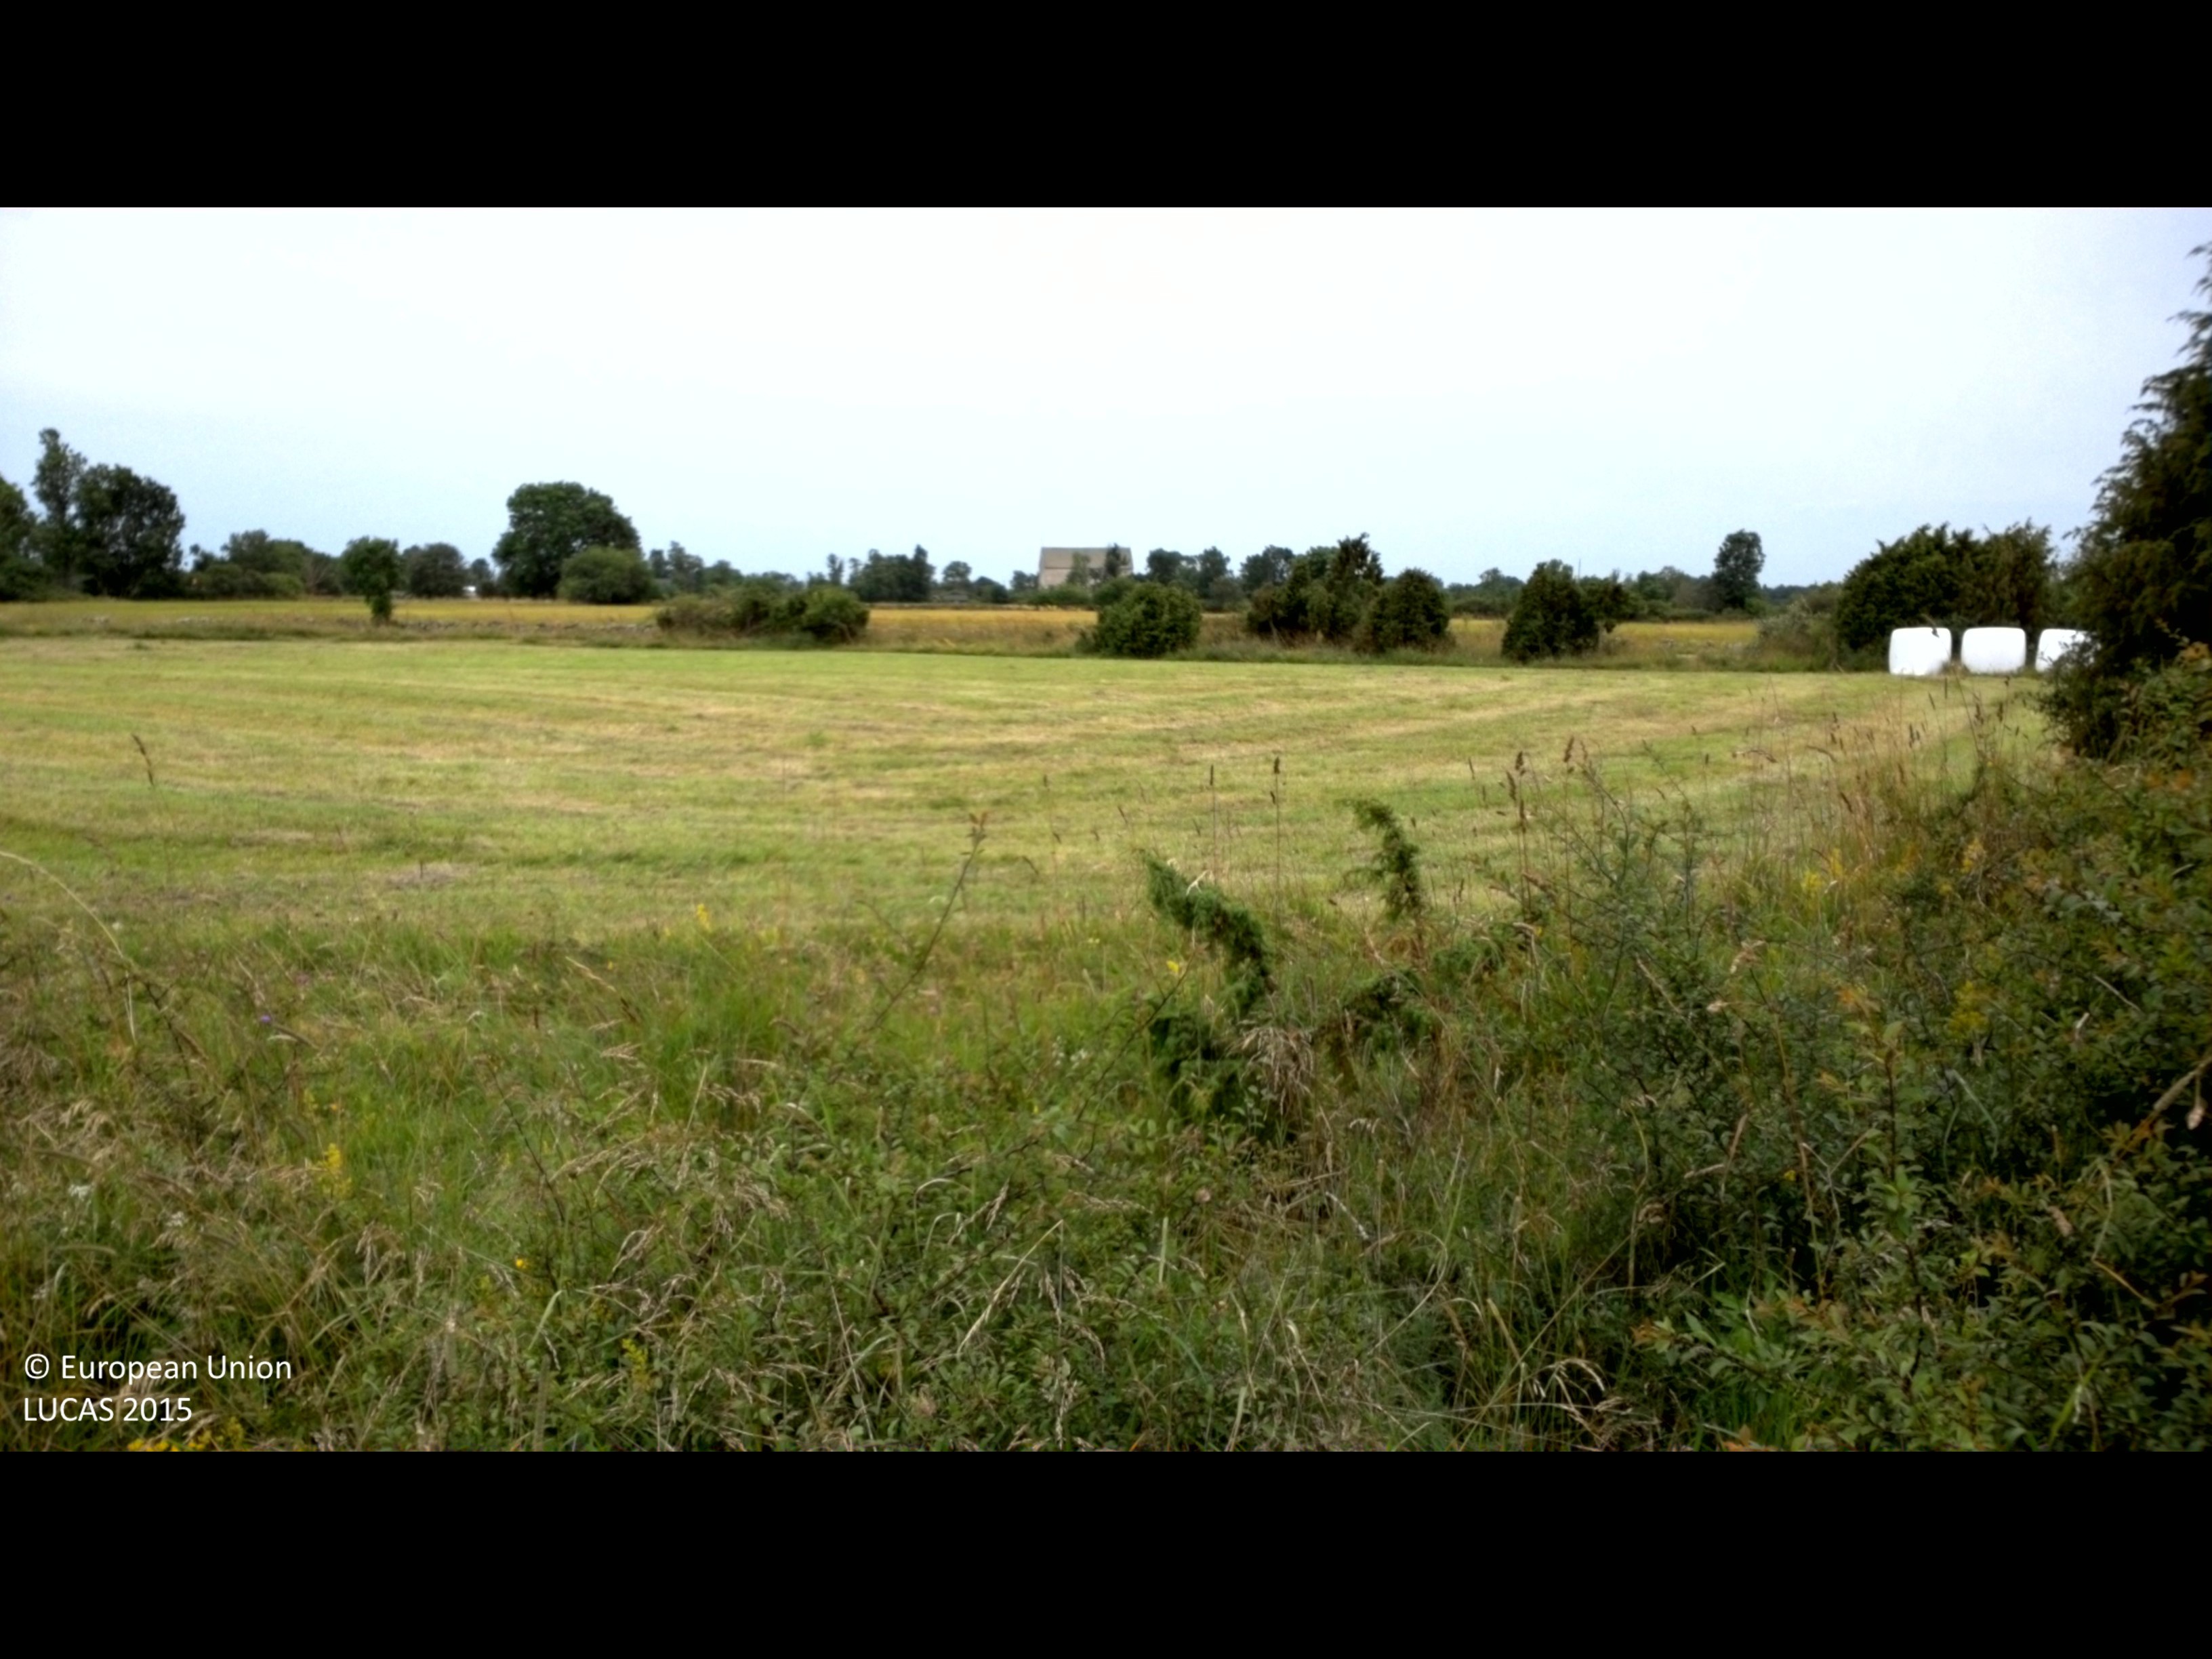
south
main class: Shrubland
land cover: Shrubland without tree cover
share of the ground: > 75 %
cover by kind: shrubs 100 %
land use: Semi-natural and natural areas not in use
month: July
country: SE
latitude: 57.1167
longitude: 16.9876
